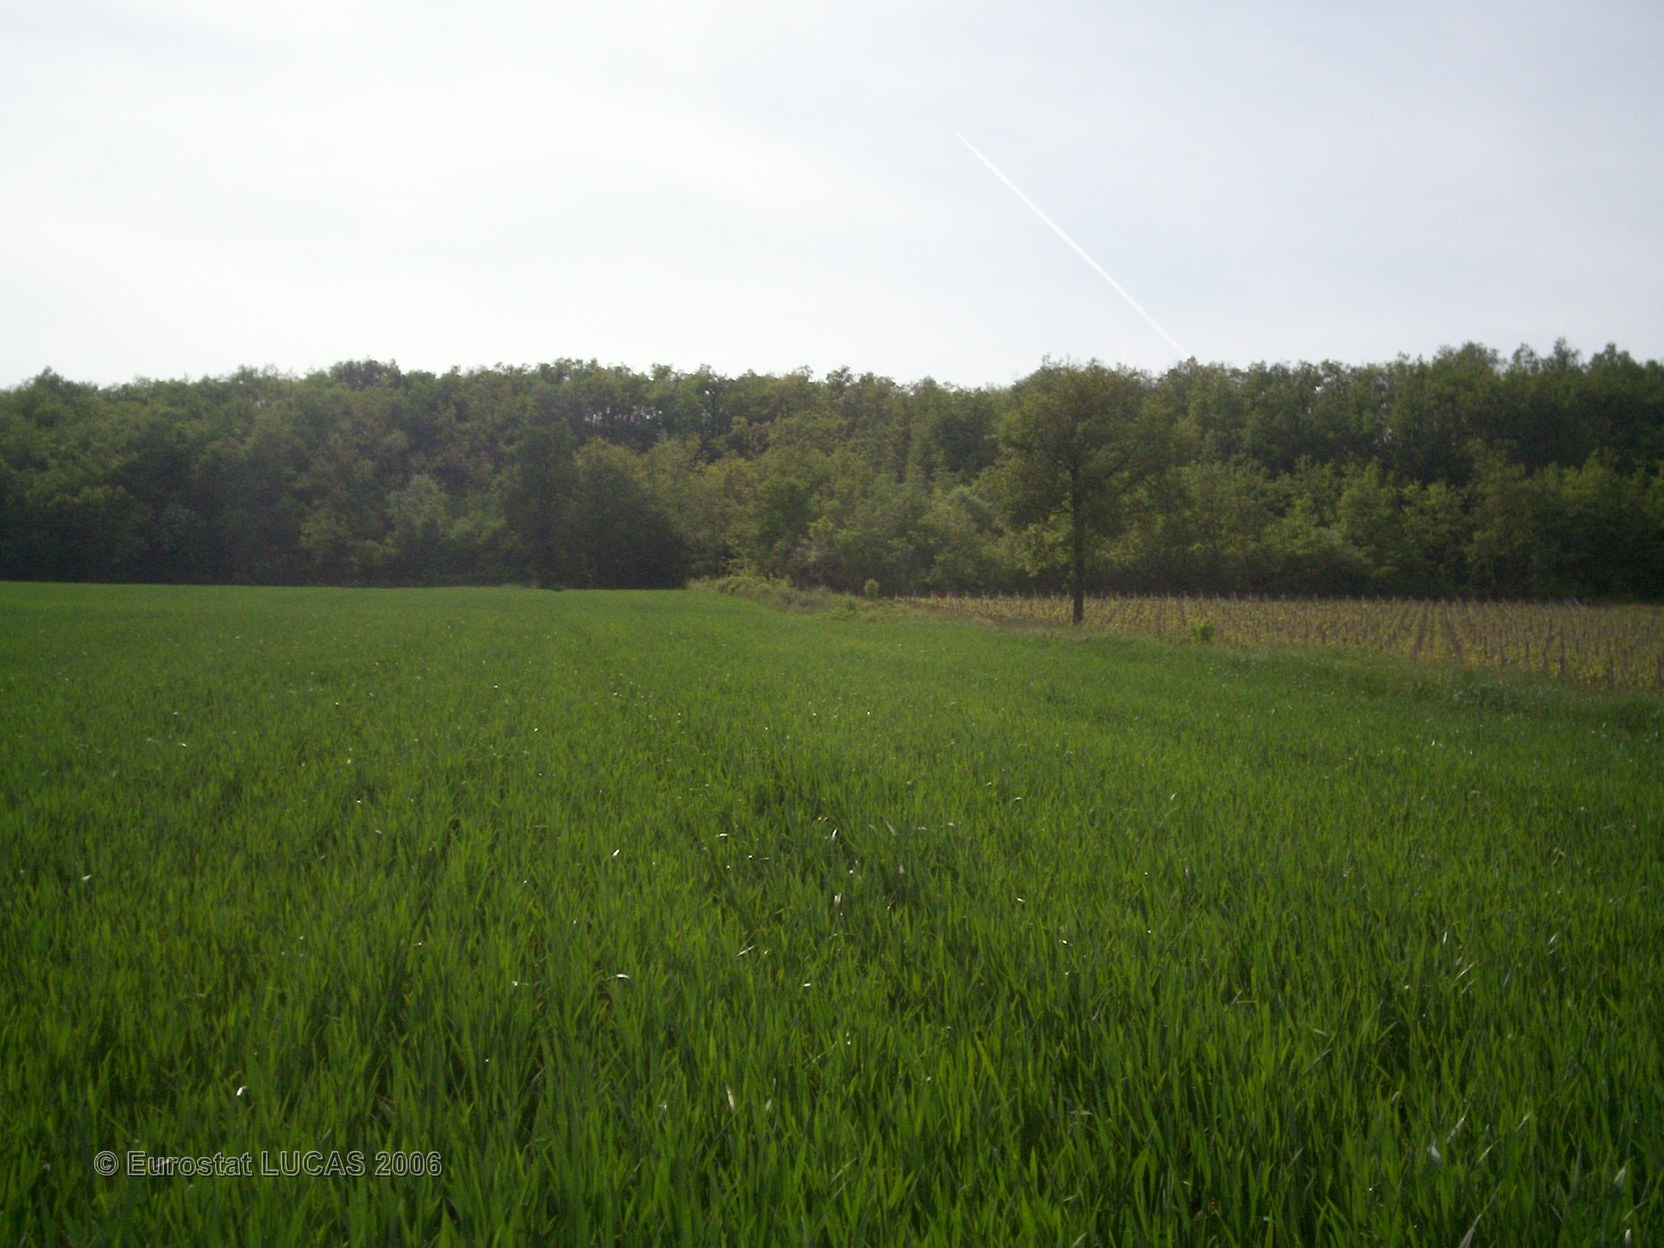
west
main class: Cropland
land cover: Common wheat
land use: Agriculture (excluding fallow land and kitchen gardens)
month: May
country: FR
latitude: 46.6675
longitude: 4.6292
